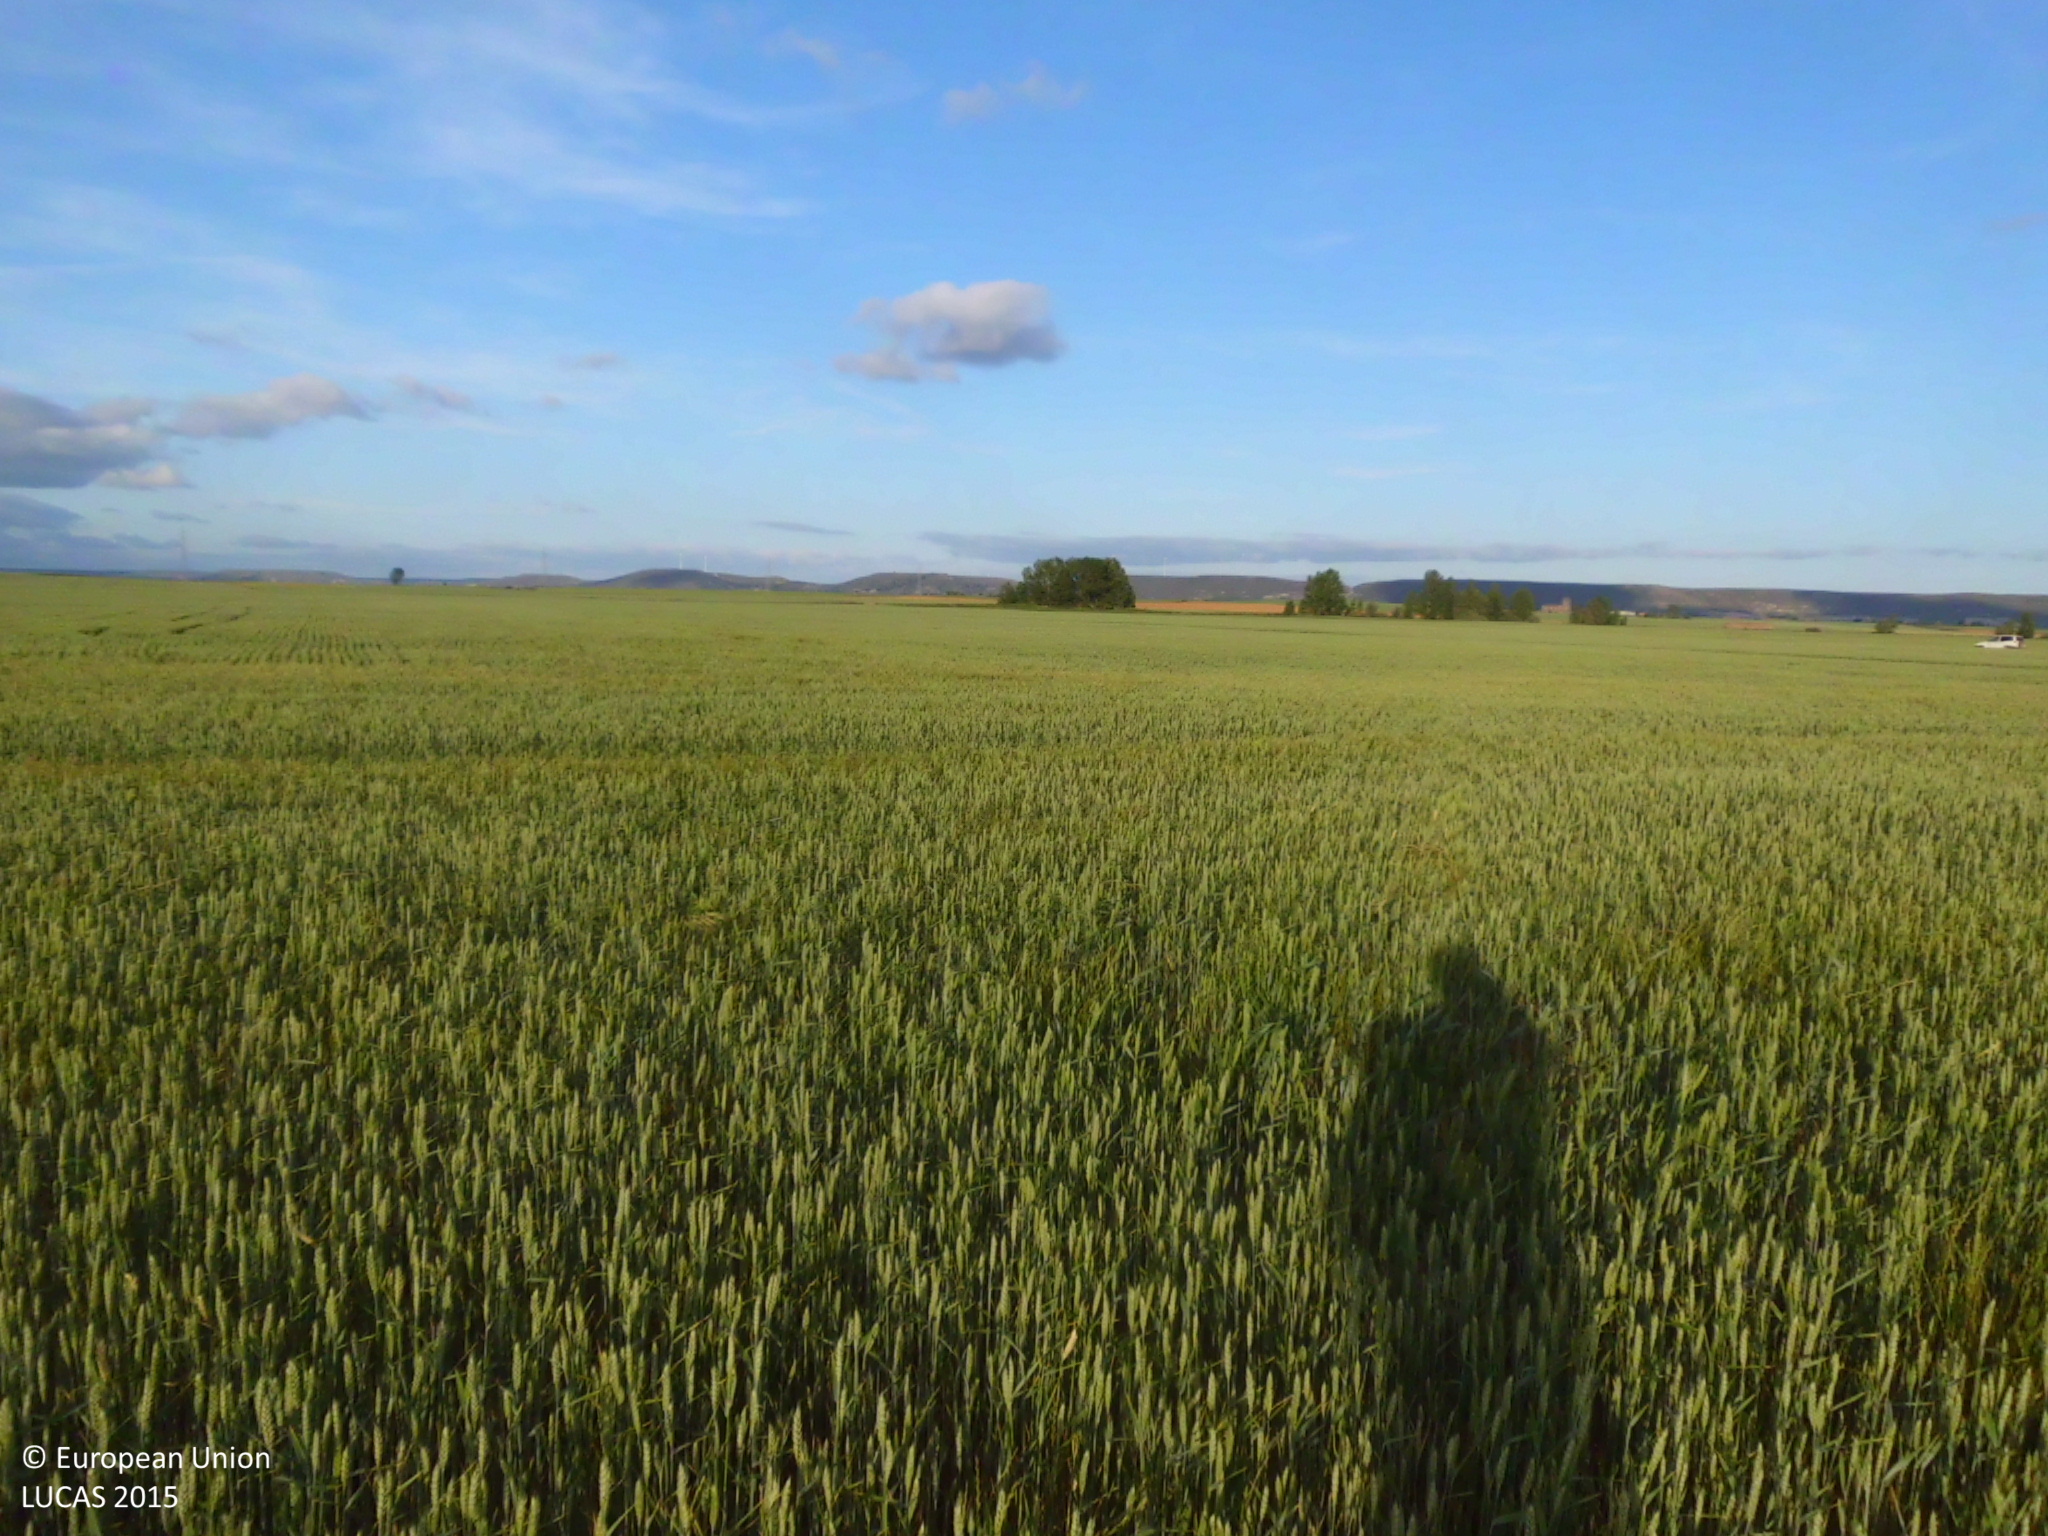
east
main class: Cropland
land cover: Common wheat
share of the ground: > 75 %
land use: Agriculture (excluding fallow land and kitchen gardens)
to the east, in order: Common wheat
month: May
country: ES
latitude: 42.3455
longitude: -4.1856
